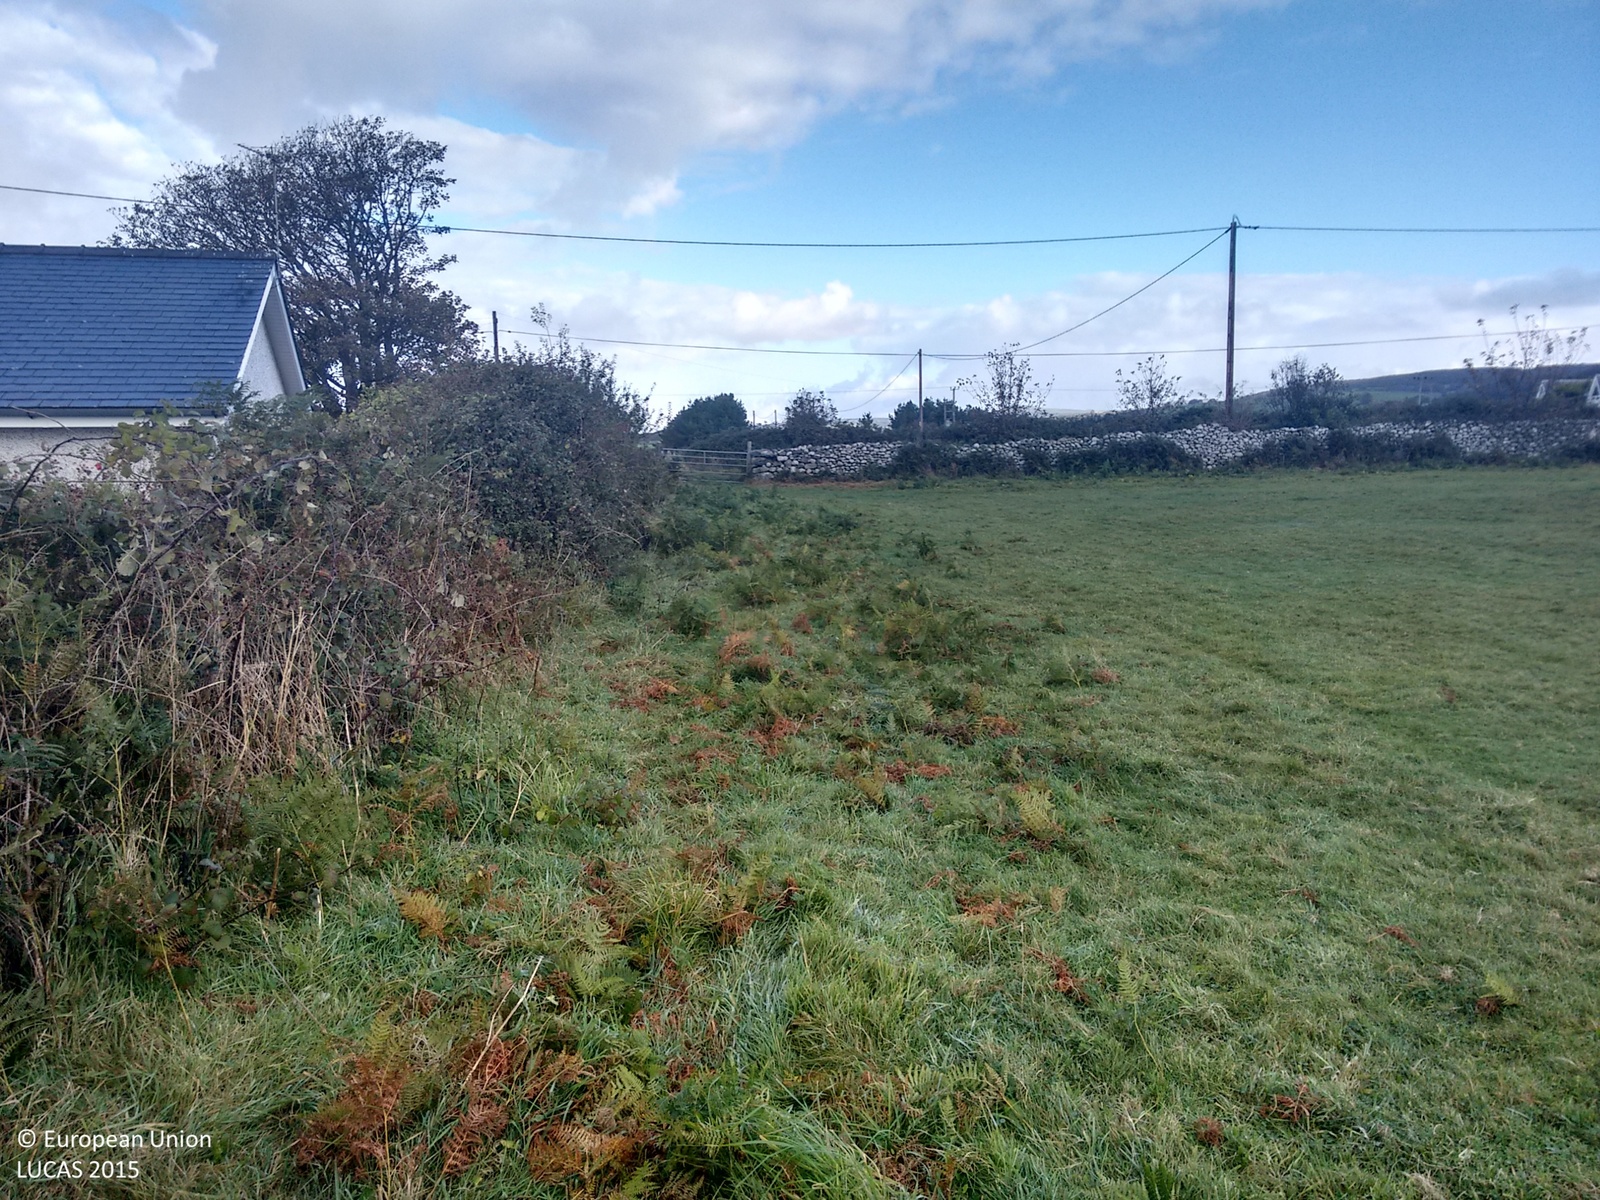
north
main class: Grassland
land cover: Grassland without tree/shrub cover
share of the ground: > 75 %
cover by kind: herbaceous plants 100 %
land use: Agriculture (excluding fallow land and kitchen gardens)
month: October
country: GB
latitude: 52.7893
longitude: -4.1096
